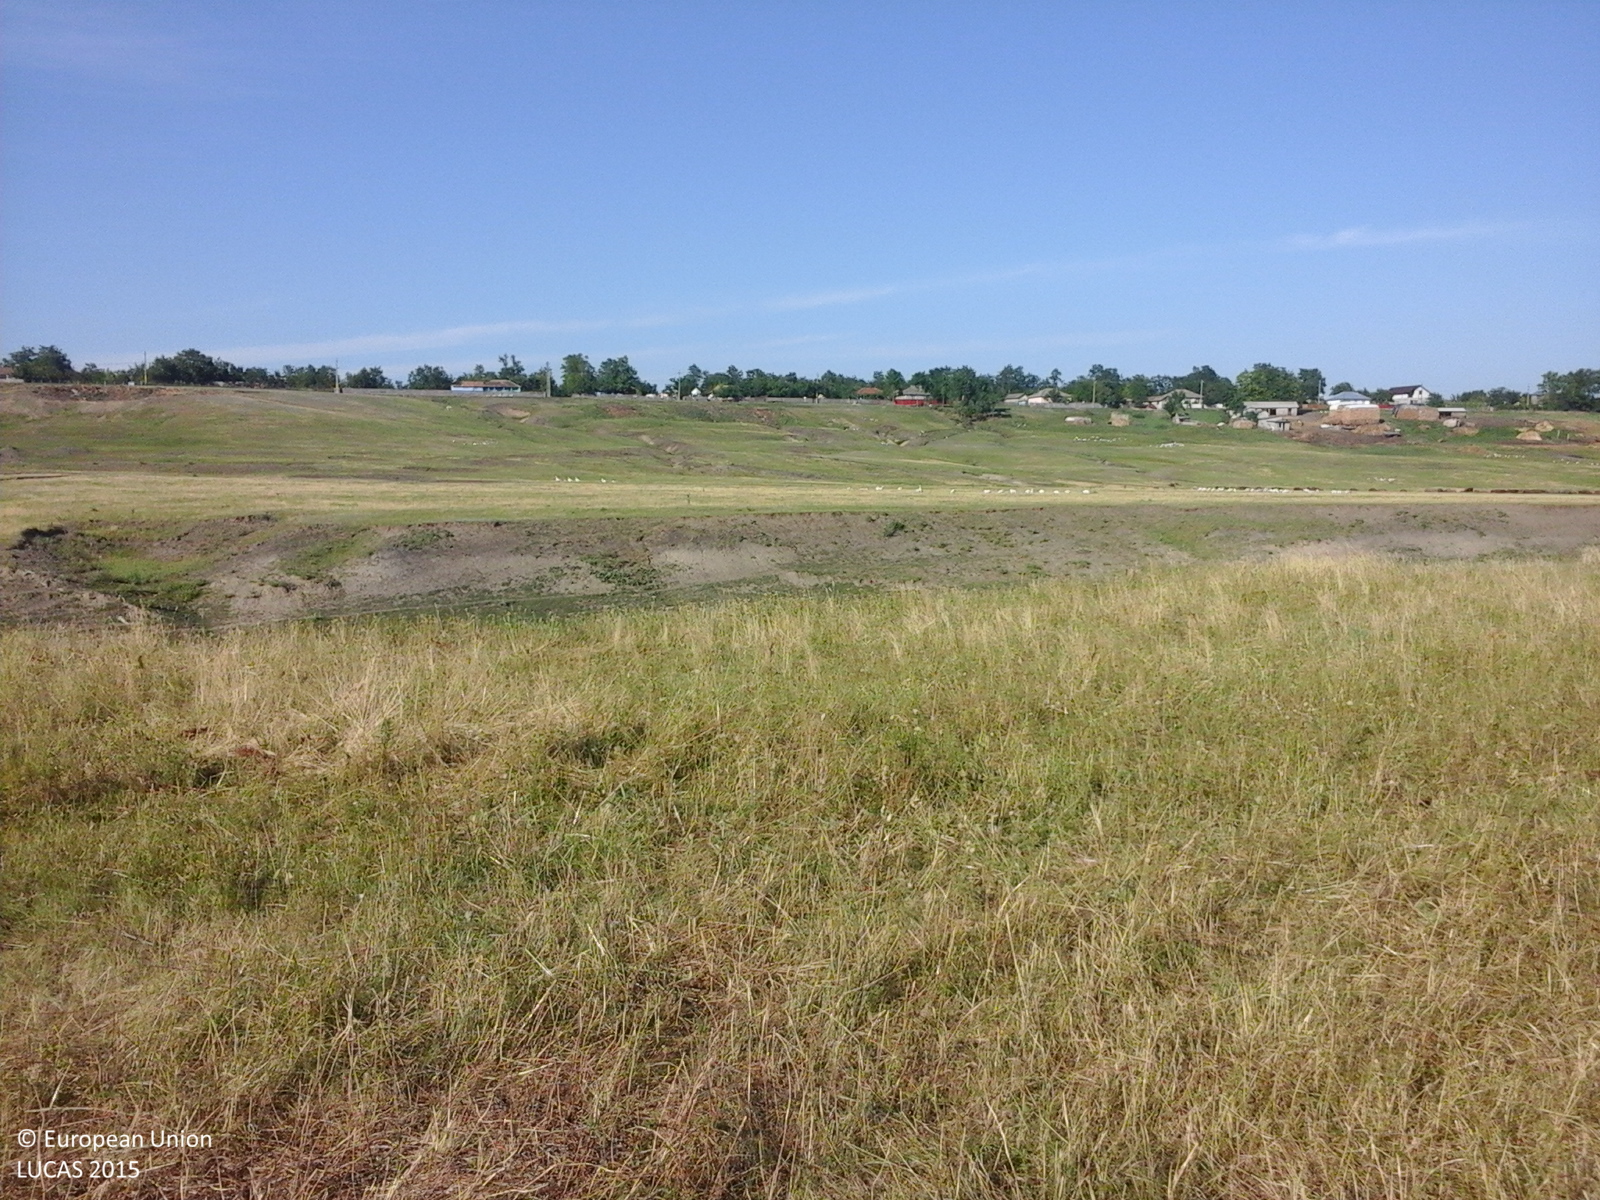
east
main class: Grassland
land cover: Grassland without tree/shrub cover
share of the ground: > 75 %
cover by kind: herbaceous plants 100 %
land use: Agriculture (excluding fallow land and kitchen gardens)
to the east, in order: Grassland without tree/shrub cover; Inland fresh running water; Grassland without tree/shrub cover
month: June
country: RO
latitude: 47.5981
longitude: 27.1728
